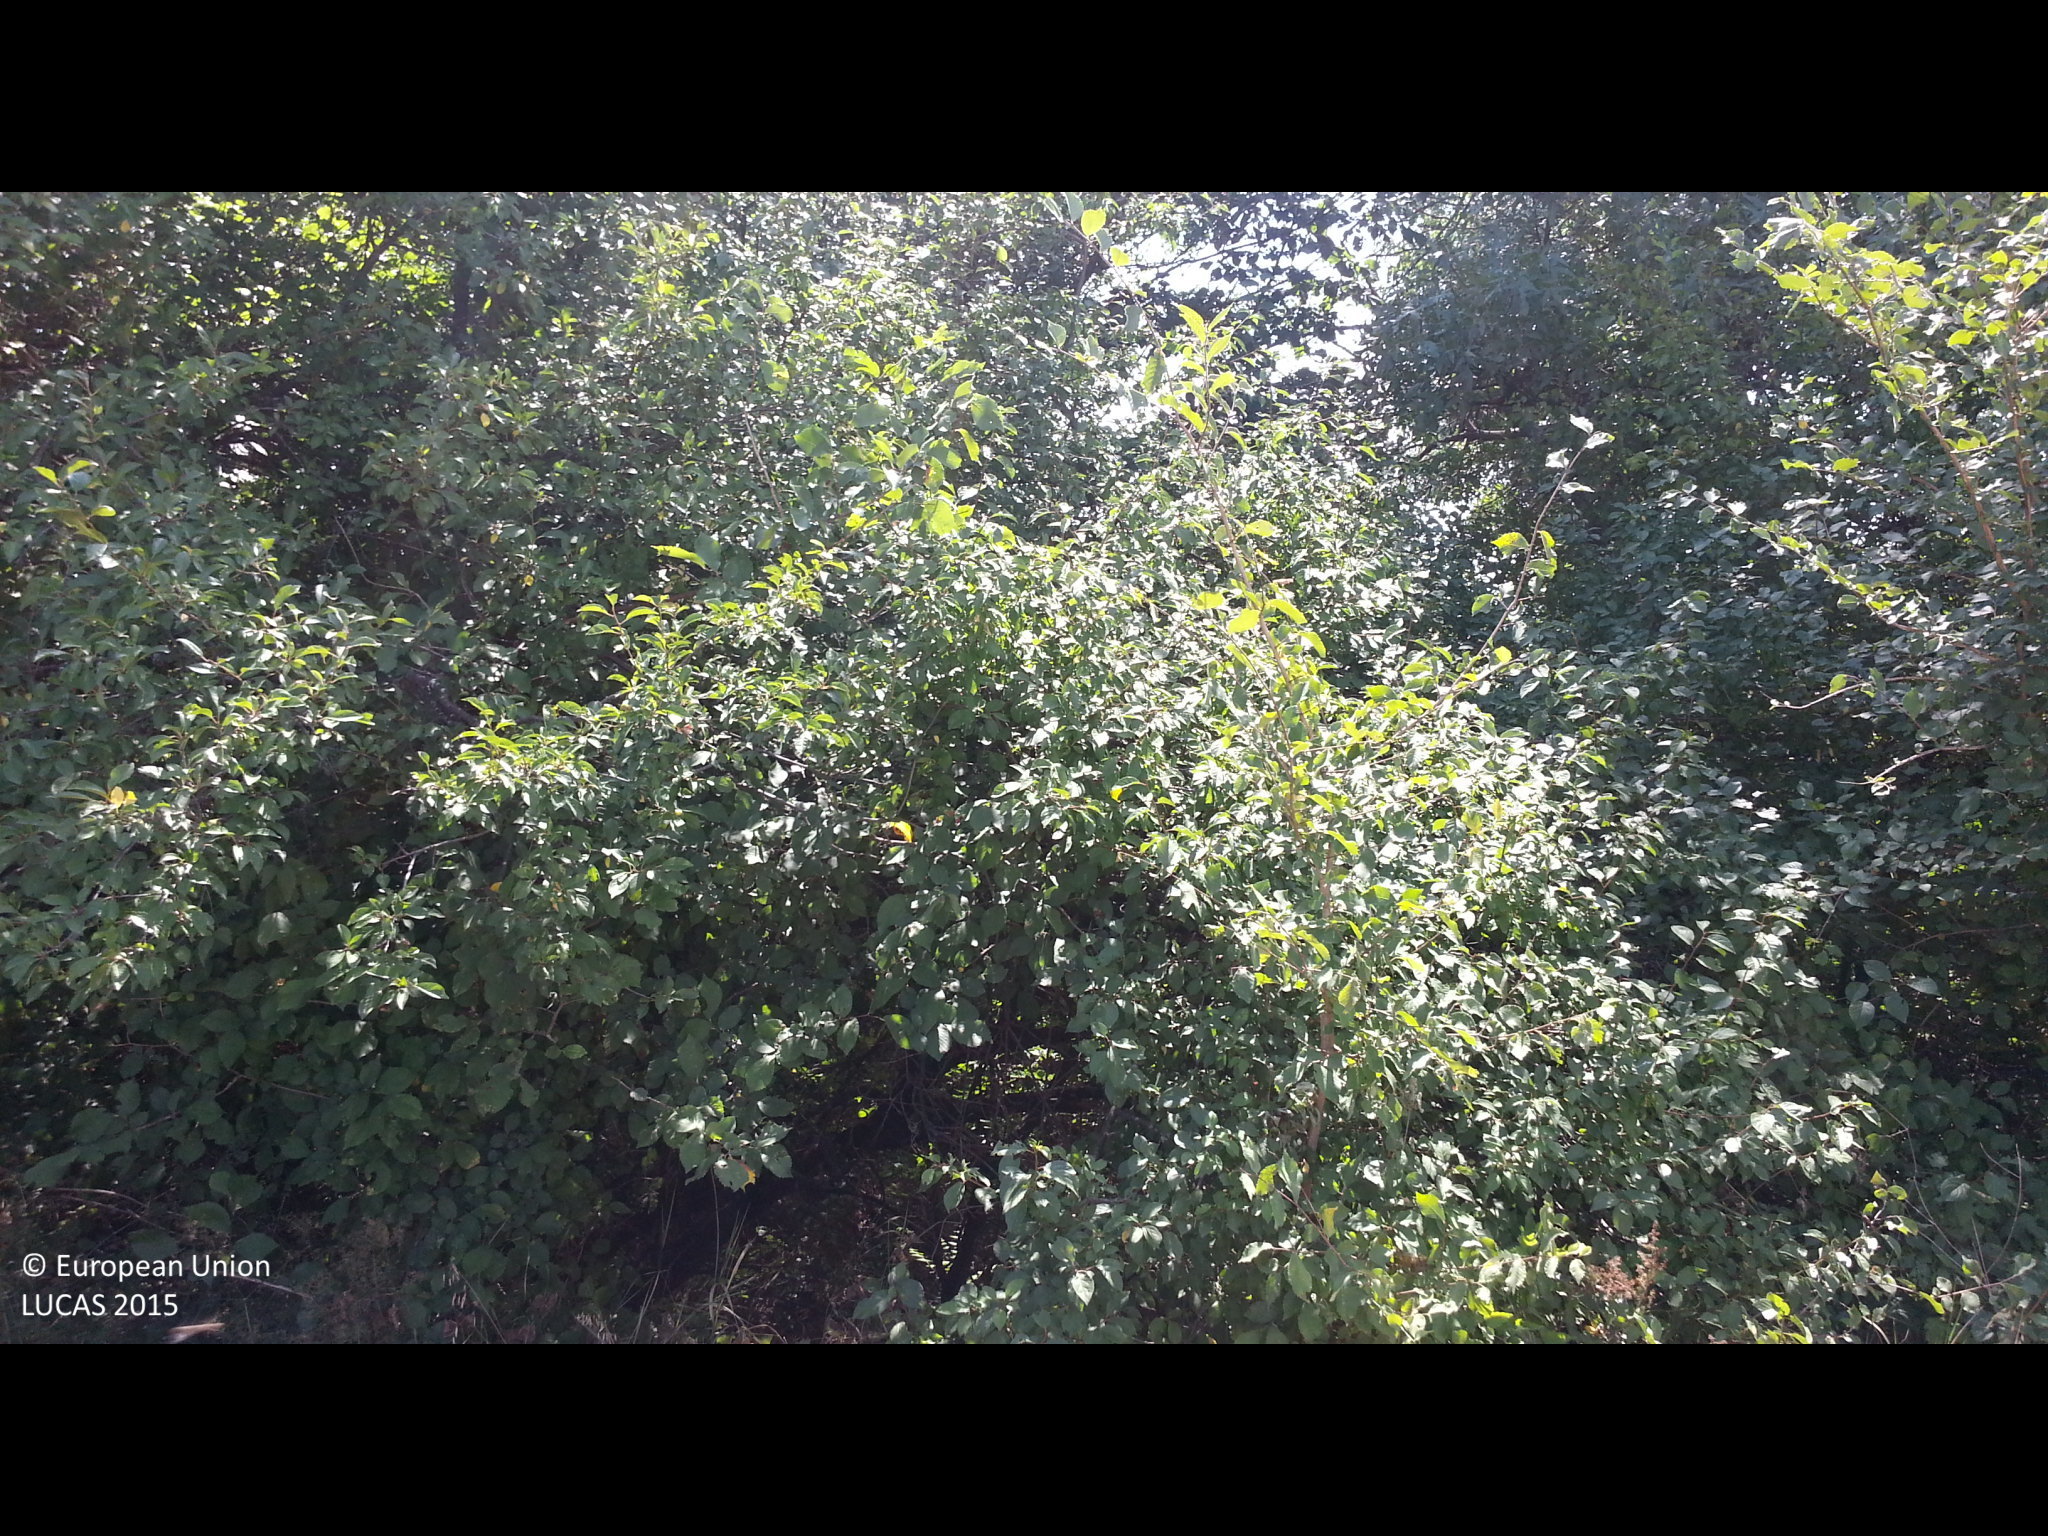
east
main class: Woodland
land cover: Broadleaved woodland
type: thermophilous deciduous forest
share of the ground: > 75 %
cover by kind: broadleaved forest trees 100 %
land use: Semi-natural and natural areas not in use
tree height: > 5 m
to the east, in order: Broadleaved woodland; Ditches and canals; Common wheat; Grass margins; Tracks; Spontaneously vegetated surfaces; Electric lines; Spontaneously vegetated surfaces
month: August
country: BG
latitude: 42.3162
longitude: 22.7749
